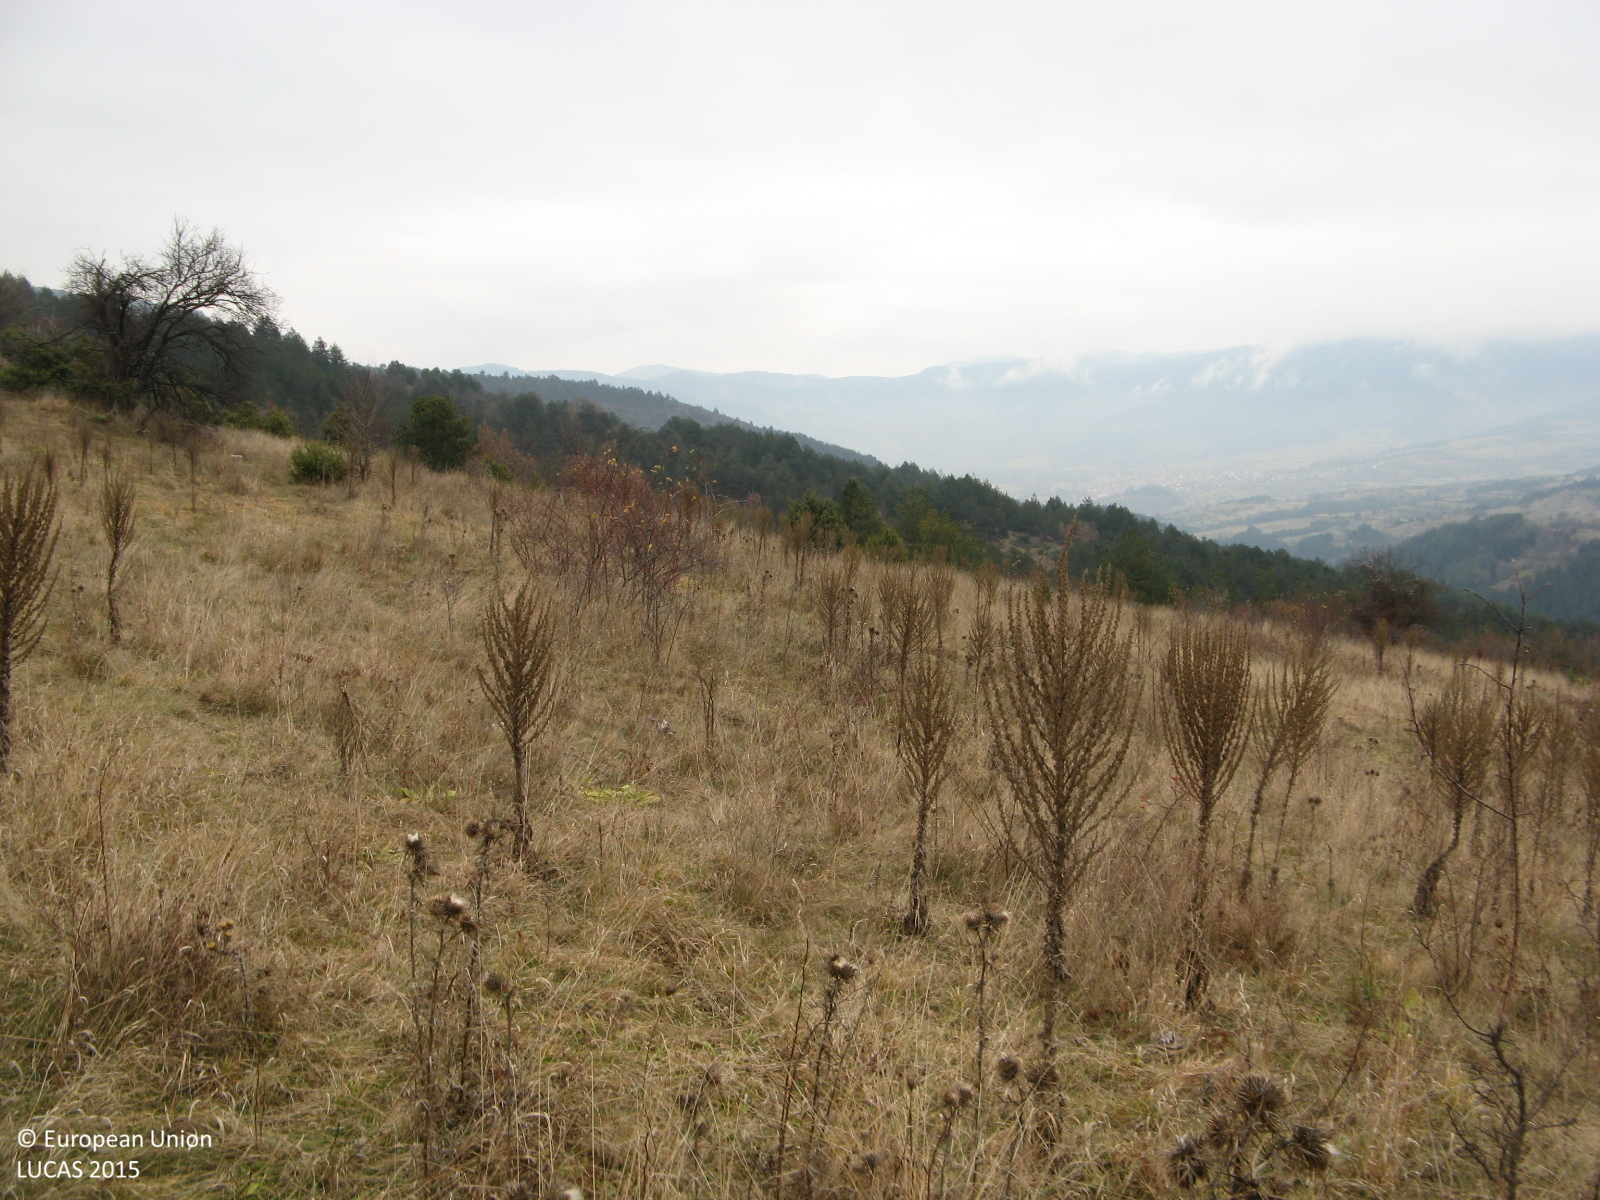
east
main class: Grassland
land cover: Grassland without tree/shrub cover
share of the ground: > 75 %
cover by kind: herbaceous plants 95 %, shrubs 5 %
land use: Agriculture (excluding fallow land and kitchen gardens)
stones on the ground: < 10 %
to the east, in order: Grassland without tree/shrub cover; Tracks; Grassland with sparse tree/shrub cover; Pine dominated mixed woodland; Tracks; Pine dominated mixed woodland; Shrubland with sparse tree cover; Broadleaved woodland
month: December
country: BG
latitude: 41.8771
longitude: 24.6384
